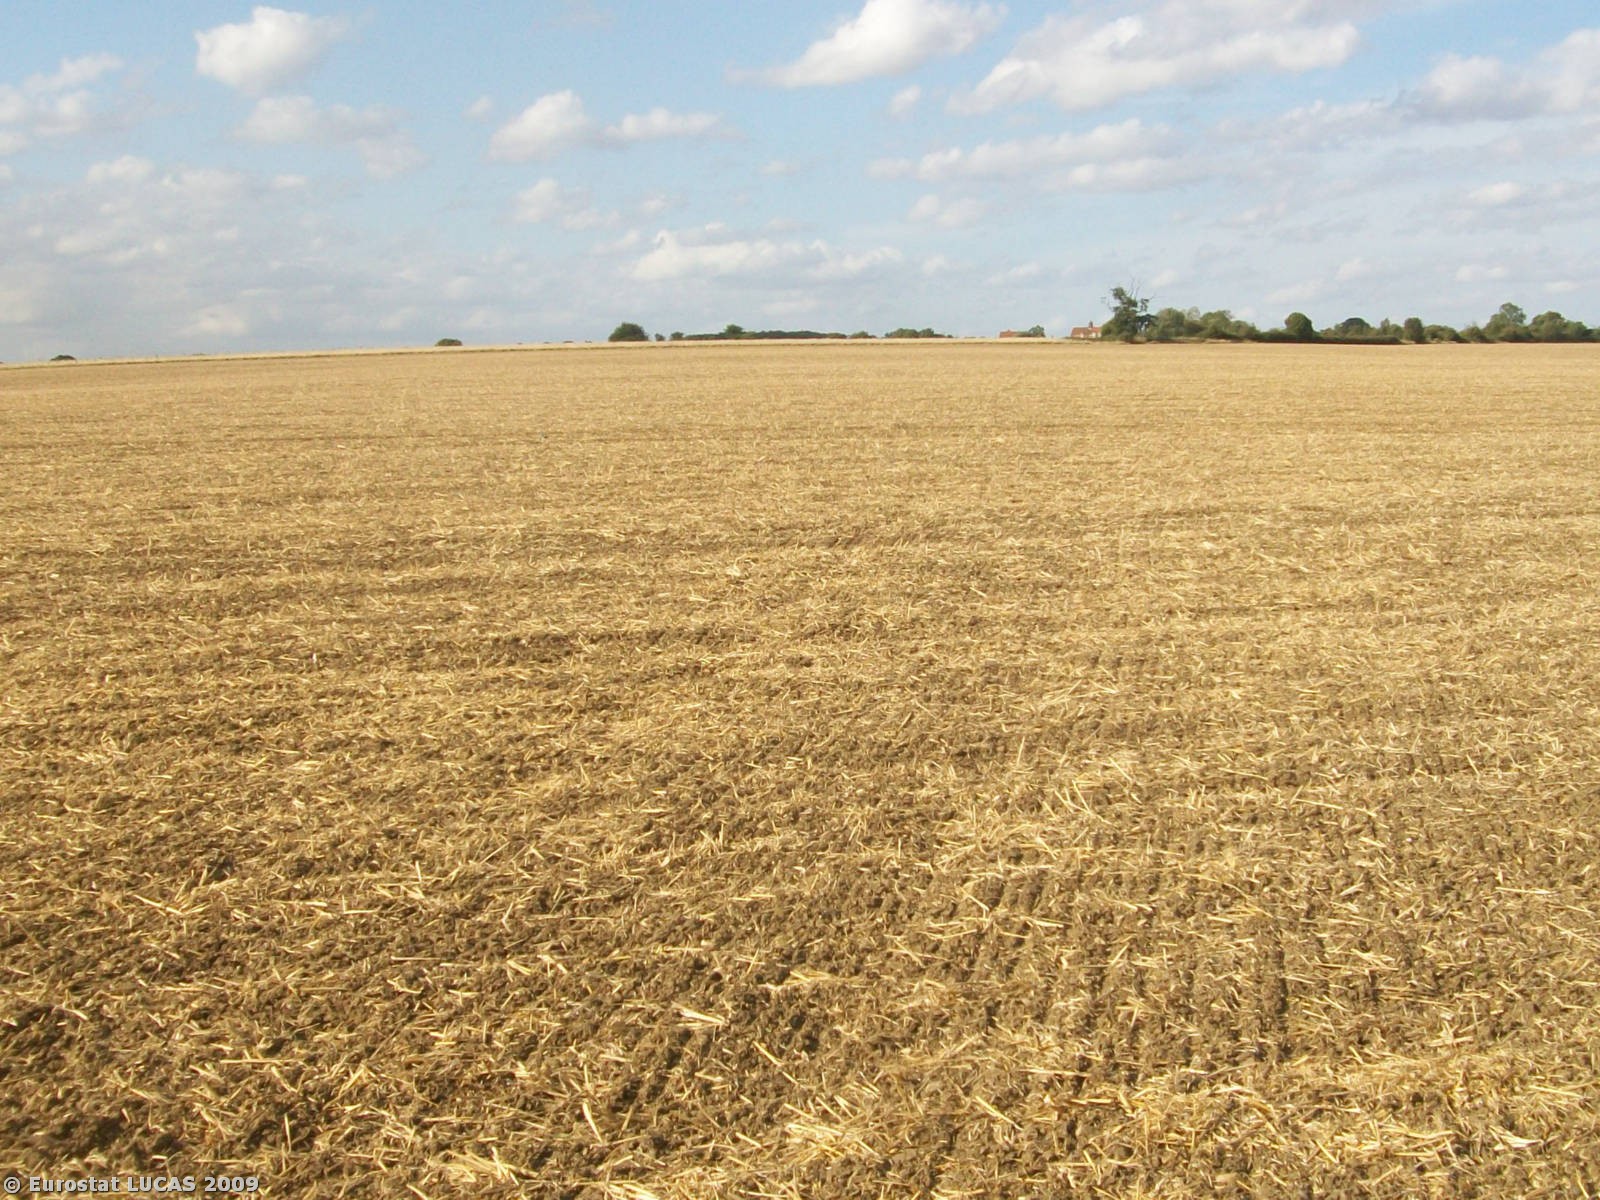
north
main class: Cropland
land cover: Common wheat
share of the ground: < 10 %
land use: Agriculture (excluding fallow land and kitchen gardens)
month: August
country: GB
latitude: 51.7279
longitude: 0.1088
